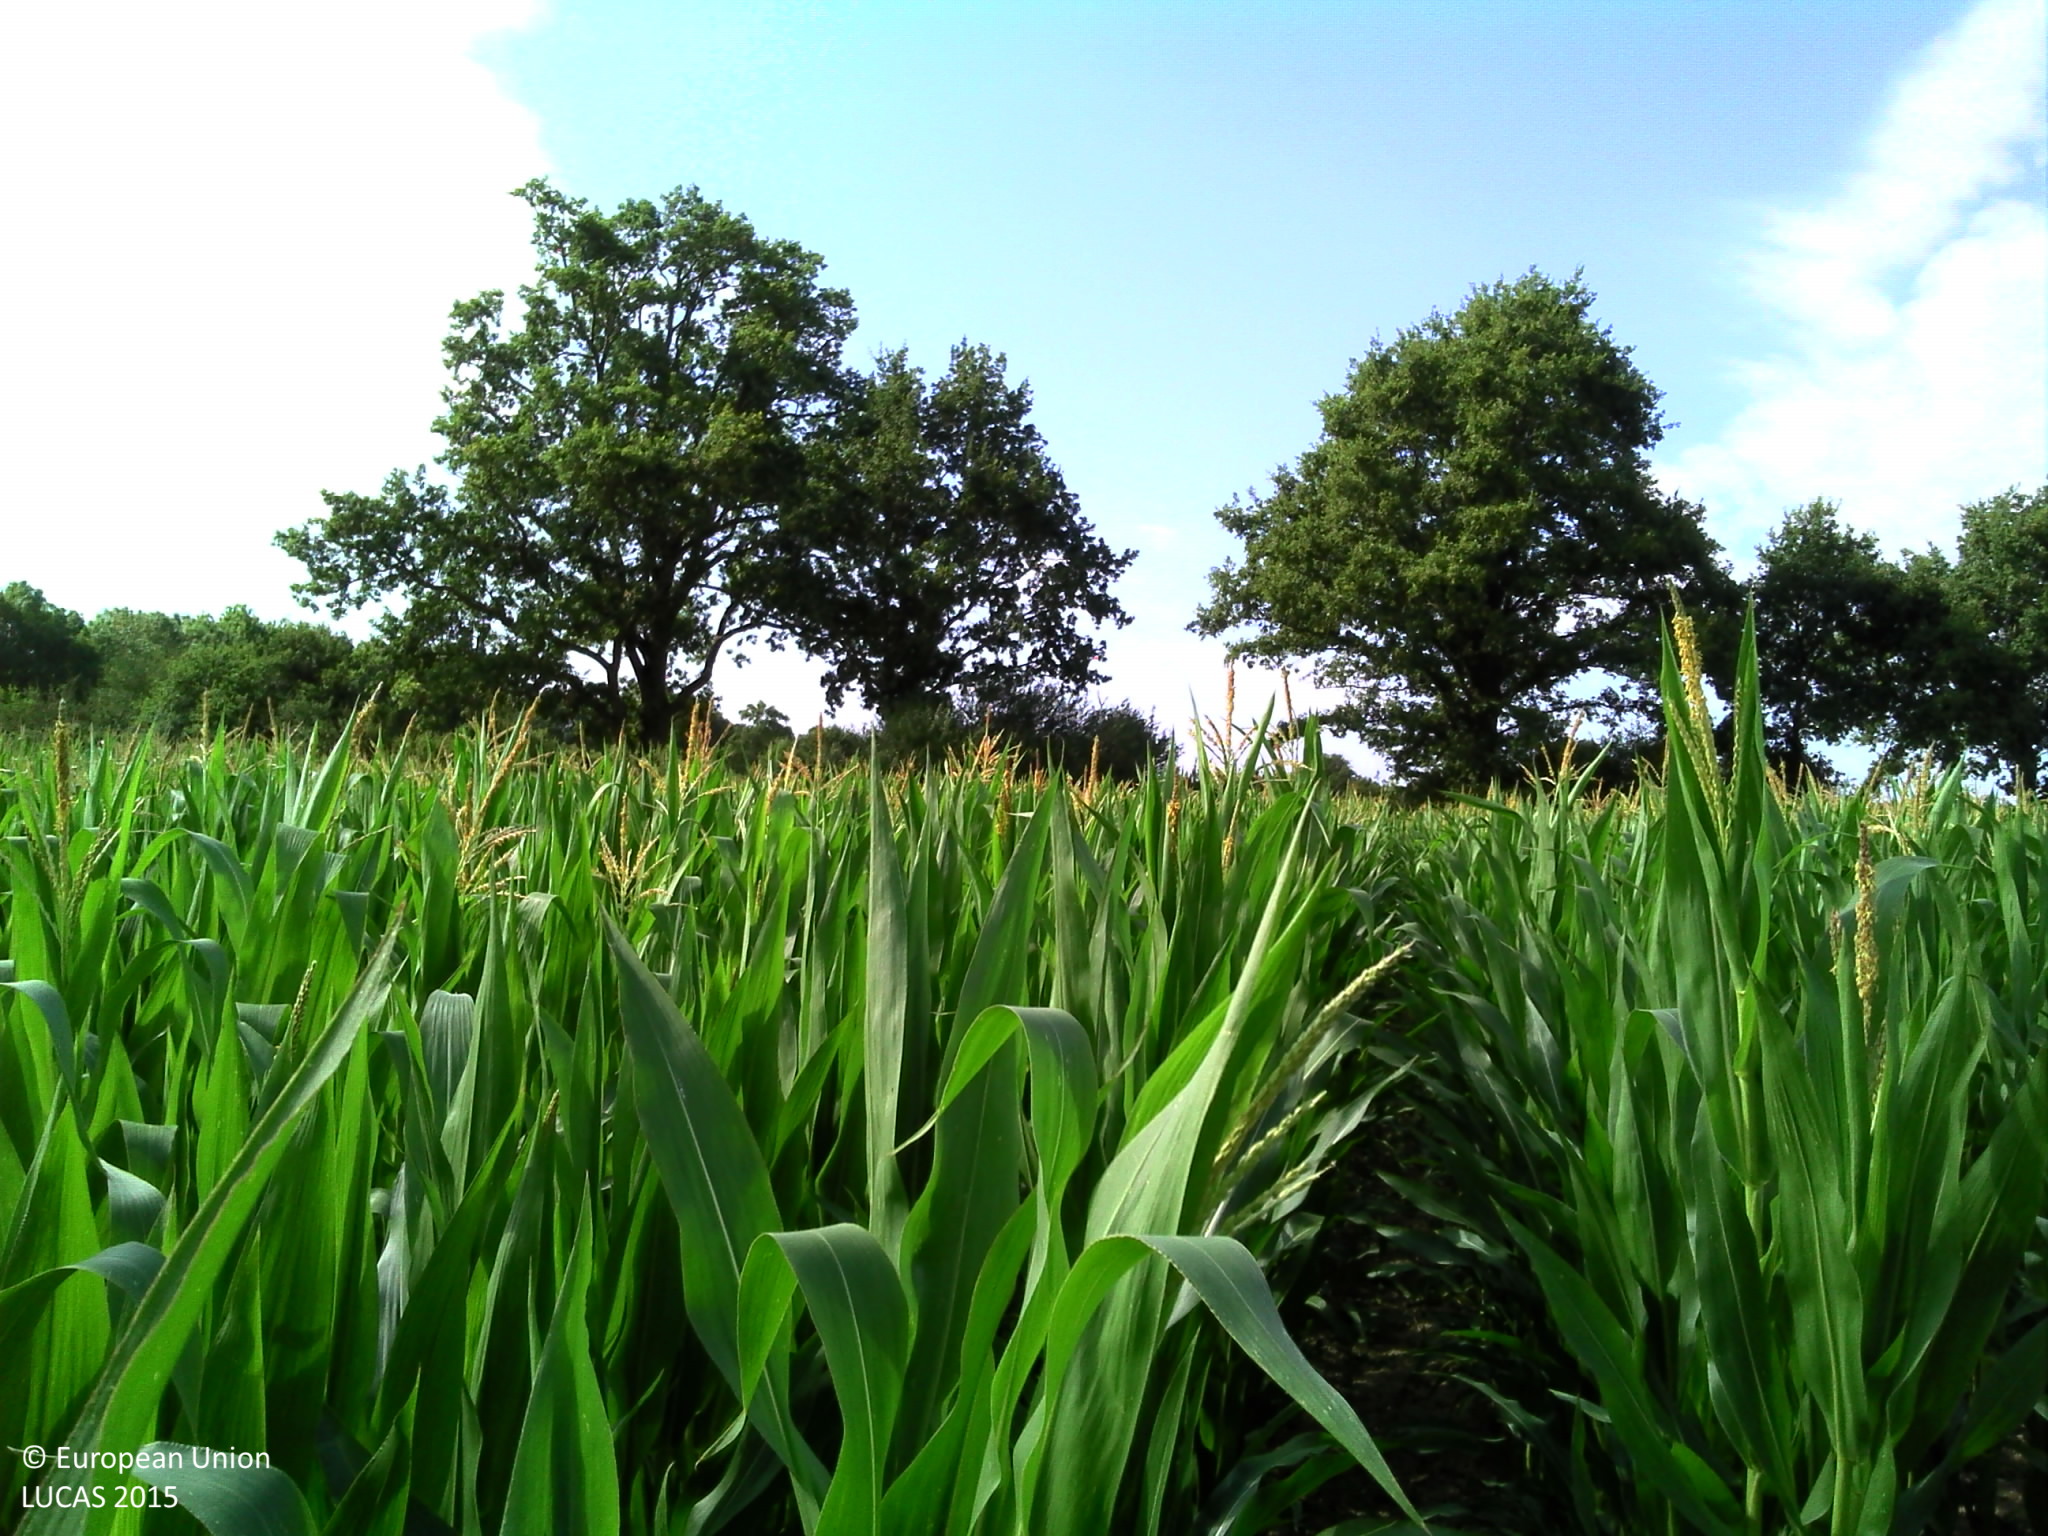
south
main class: Cropland
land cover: Maize
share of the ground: 25 - 50 %
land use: Agriculture (excluding fallow land and kitchen gardens)
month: August
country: FR
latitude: 47.4260
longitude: -1.7783
